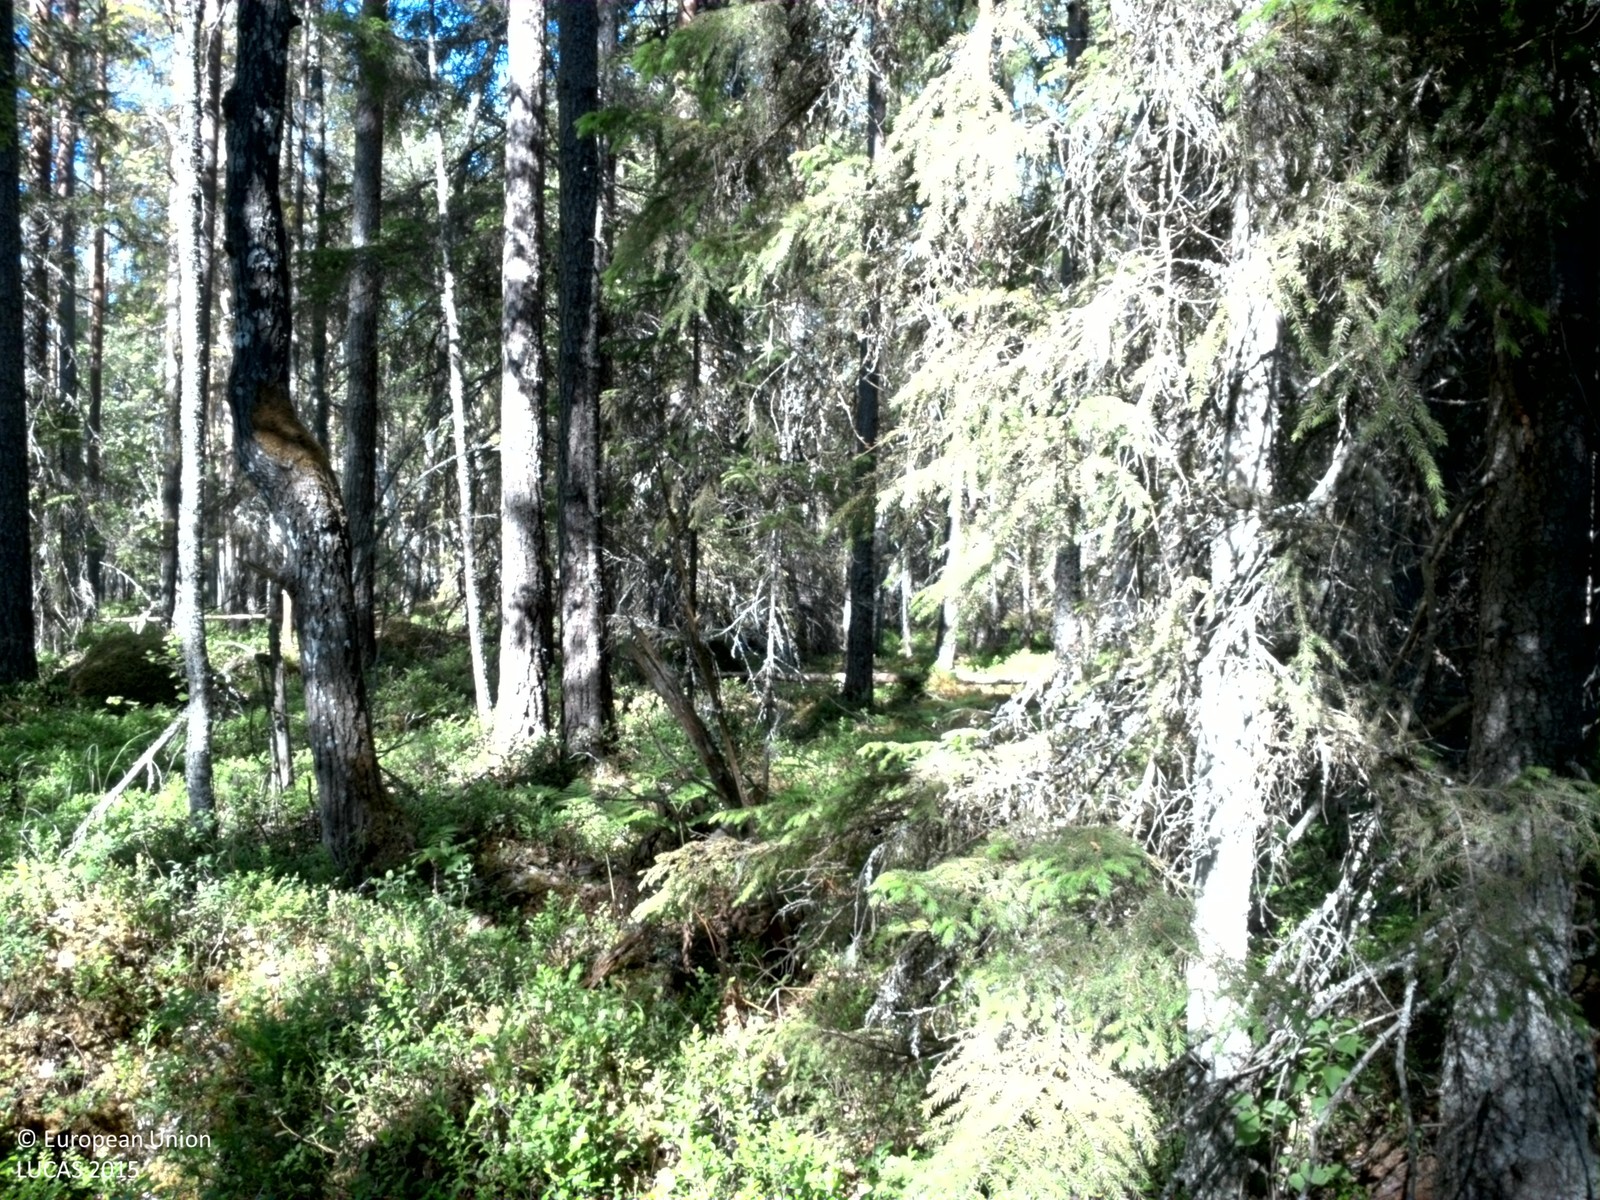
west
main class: Woodland
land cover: Other coniferous woodland
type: boreal forest
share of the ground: 50 - 75 %
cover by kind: coniferous forest trees 60 %, herbaceous plants 30 %, broadleaved forest trees 10 %
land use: Amenities, museums, leisure
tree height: > 5 m
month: June
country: SE
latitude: 60.2518
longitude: 17.1639
